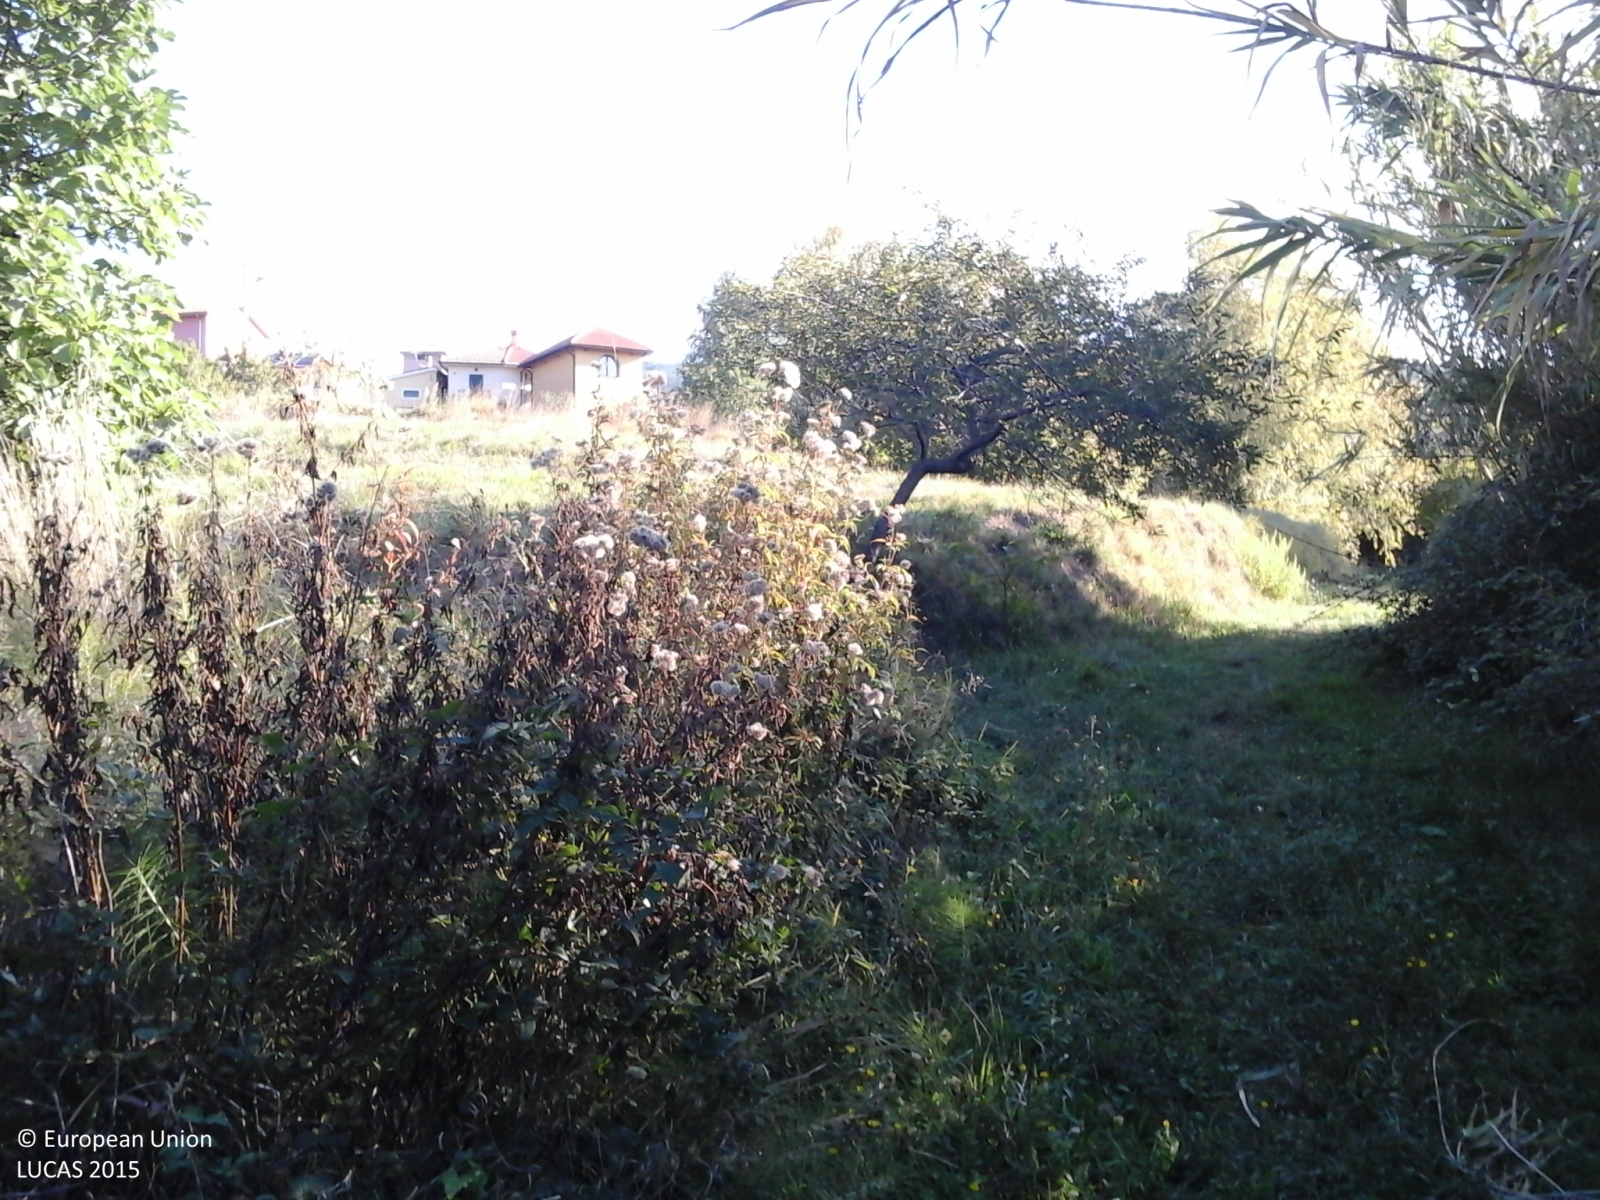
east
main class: Grassland
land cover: Grassland with sparse tree/shrub cover
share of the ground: > 75 %
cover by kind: herbaceous plants 80 %, shrubs 10 %, broadleaved forest trees 5 %, lichens and mosses 5 %
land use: Agriculture (excluding fallow land and kitchen gardens)
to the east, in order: Grassland with sparse tree/shrub cover; Shrubland with sparse tree cover; Fences; Grassland with sparse tree/shrub cover; Broadleaved woodland; Artificial constructions in urban areas; Grassland without tree/shrub cover; Tracks; Grassland without tree/shrub cover; Artificial constructions in urban areas; Other fresh vegetables; Other fruit trees and berries; Apple fruit; Grassland with sparse tree/shrub cover; Shrubland with sparse tree cover; Paved roads, cycling and walking lanes; Electric lines; Shrubland with sparse tree cover; Electric lines; Grassland with sparse tree/shrub cover; Broadleaved woodland
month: September
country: IT
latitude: 44.3936
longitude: 8.4843
